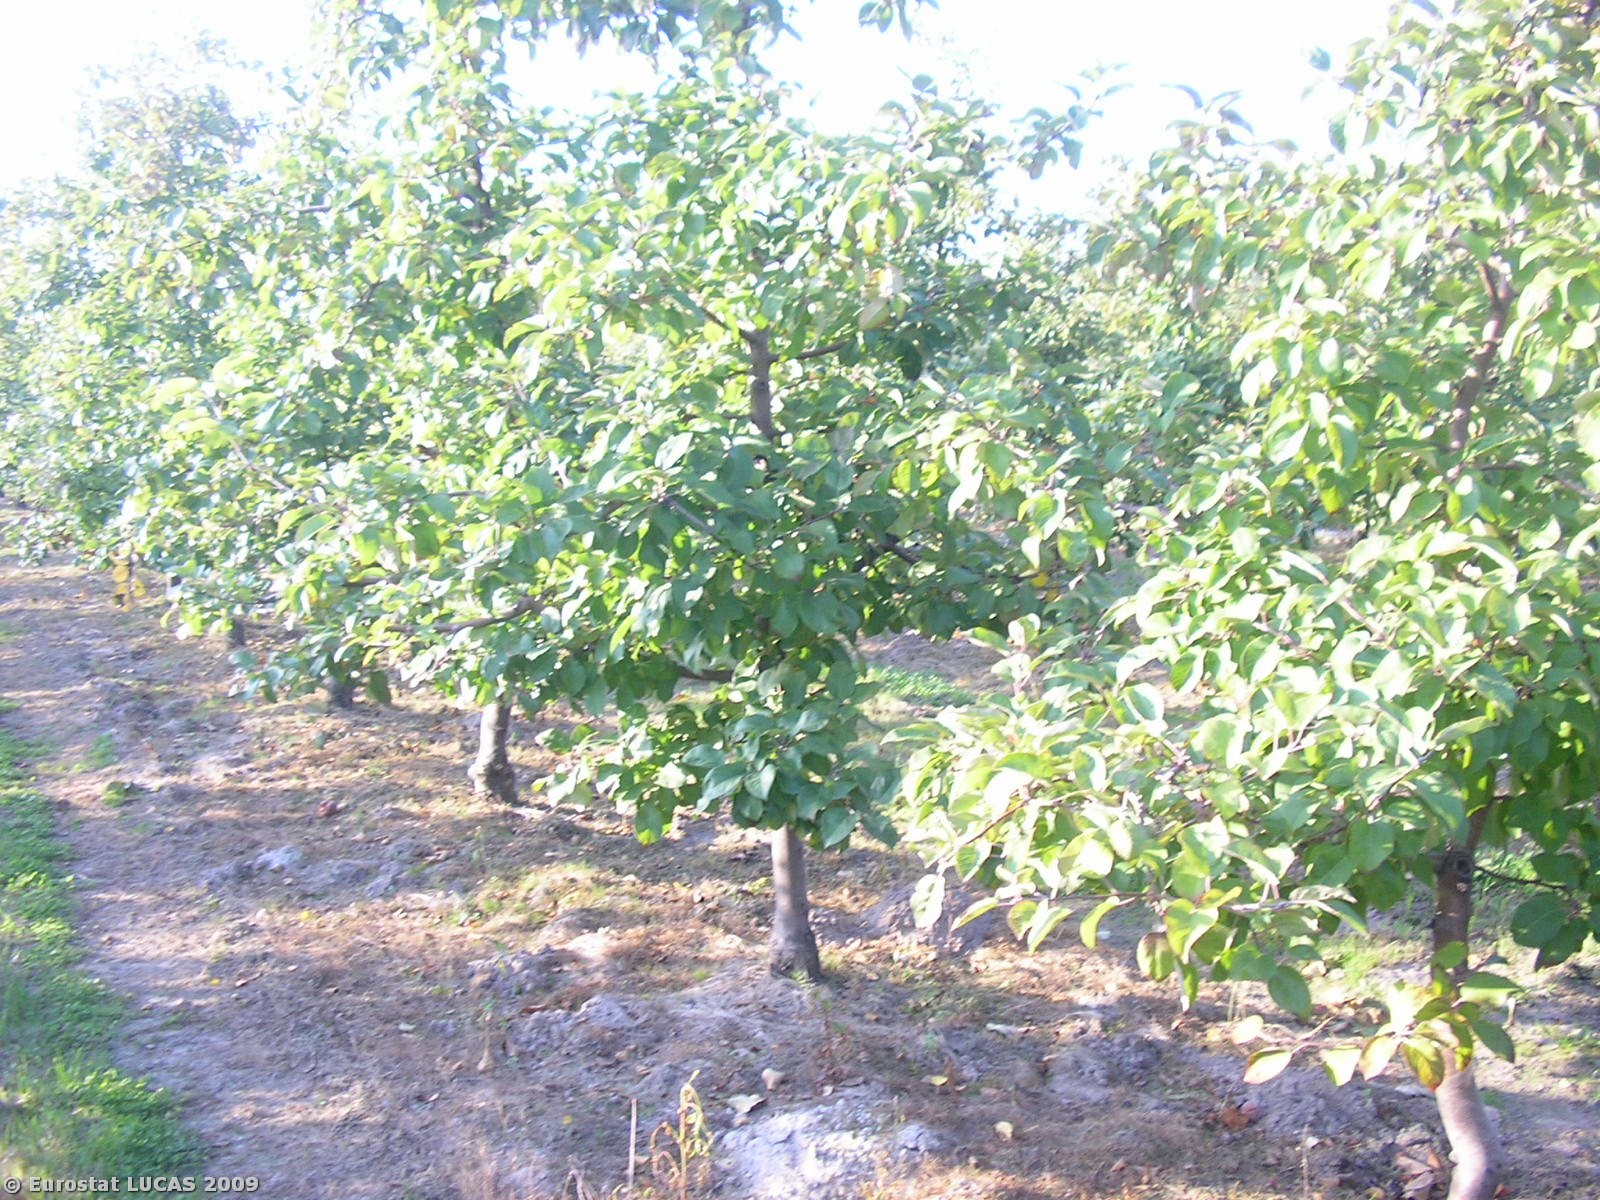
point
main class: Cropland
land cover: Apple fruit
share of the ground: 25 - 50 %
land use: Agriculture (excluding fallow land and kitchen gardens)
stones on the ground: < 10 %
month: September
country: PL
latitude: 51.8168
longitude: 20.7325
